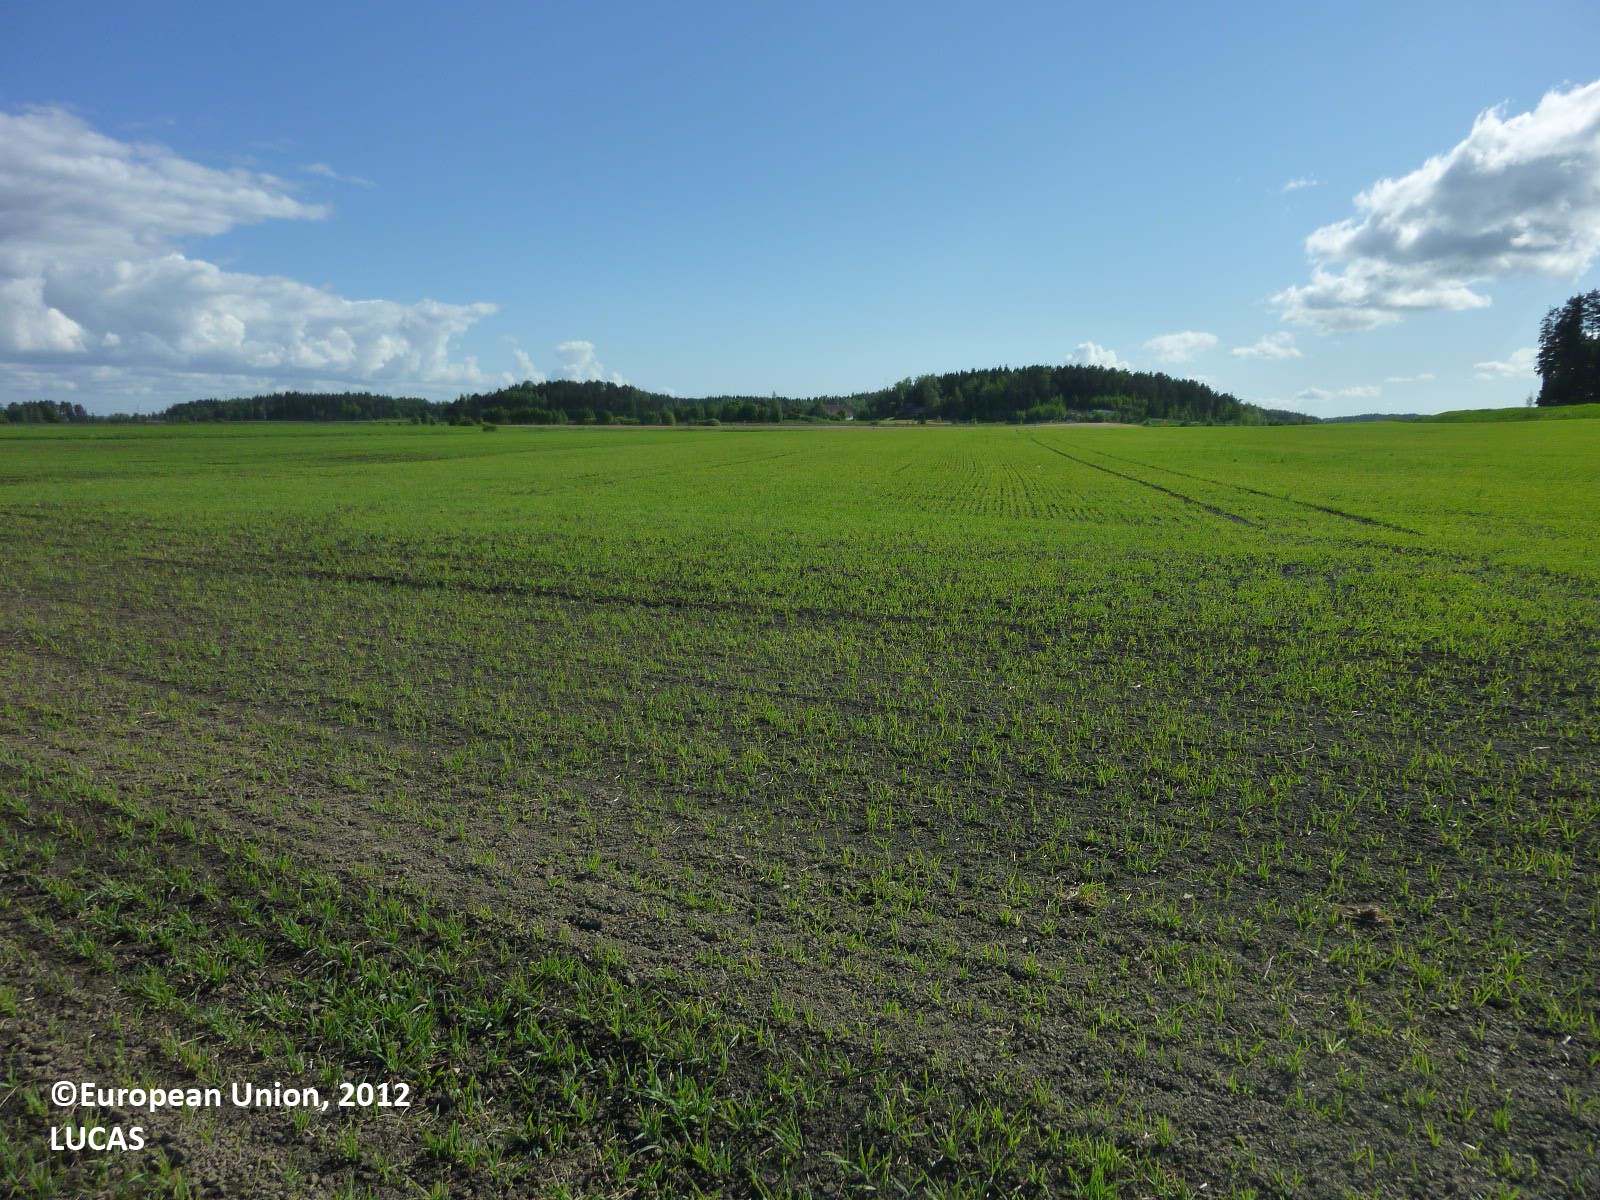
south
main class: Cropland
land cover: Barley
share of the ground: > 75 %
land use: Agriculture (excluding fallow land and kitchen gardens)
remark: Tilled/Sowed
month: June
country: FI
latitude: 60.4678
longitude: 22.6401
